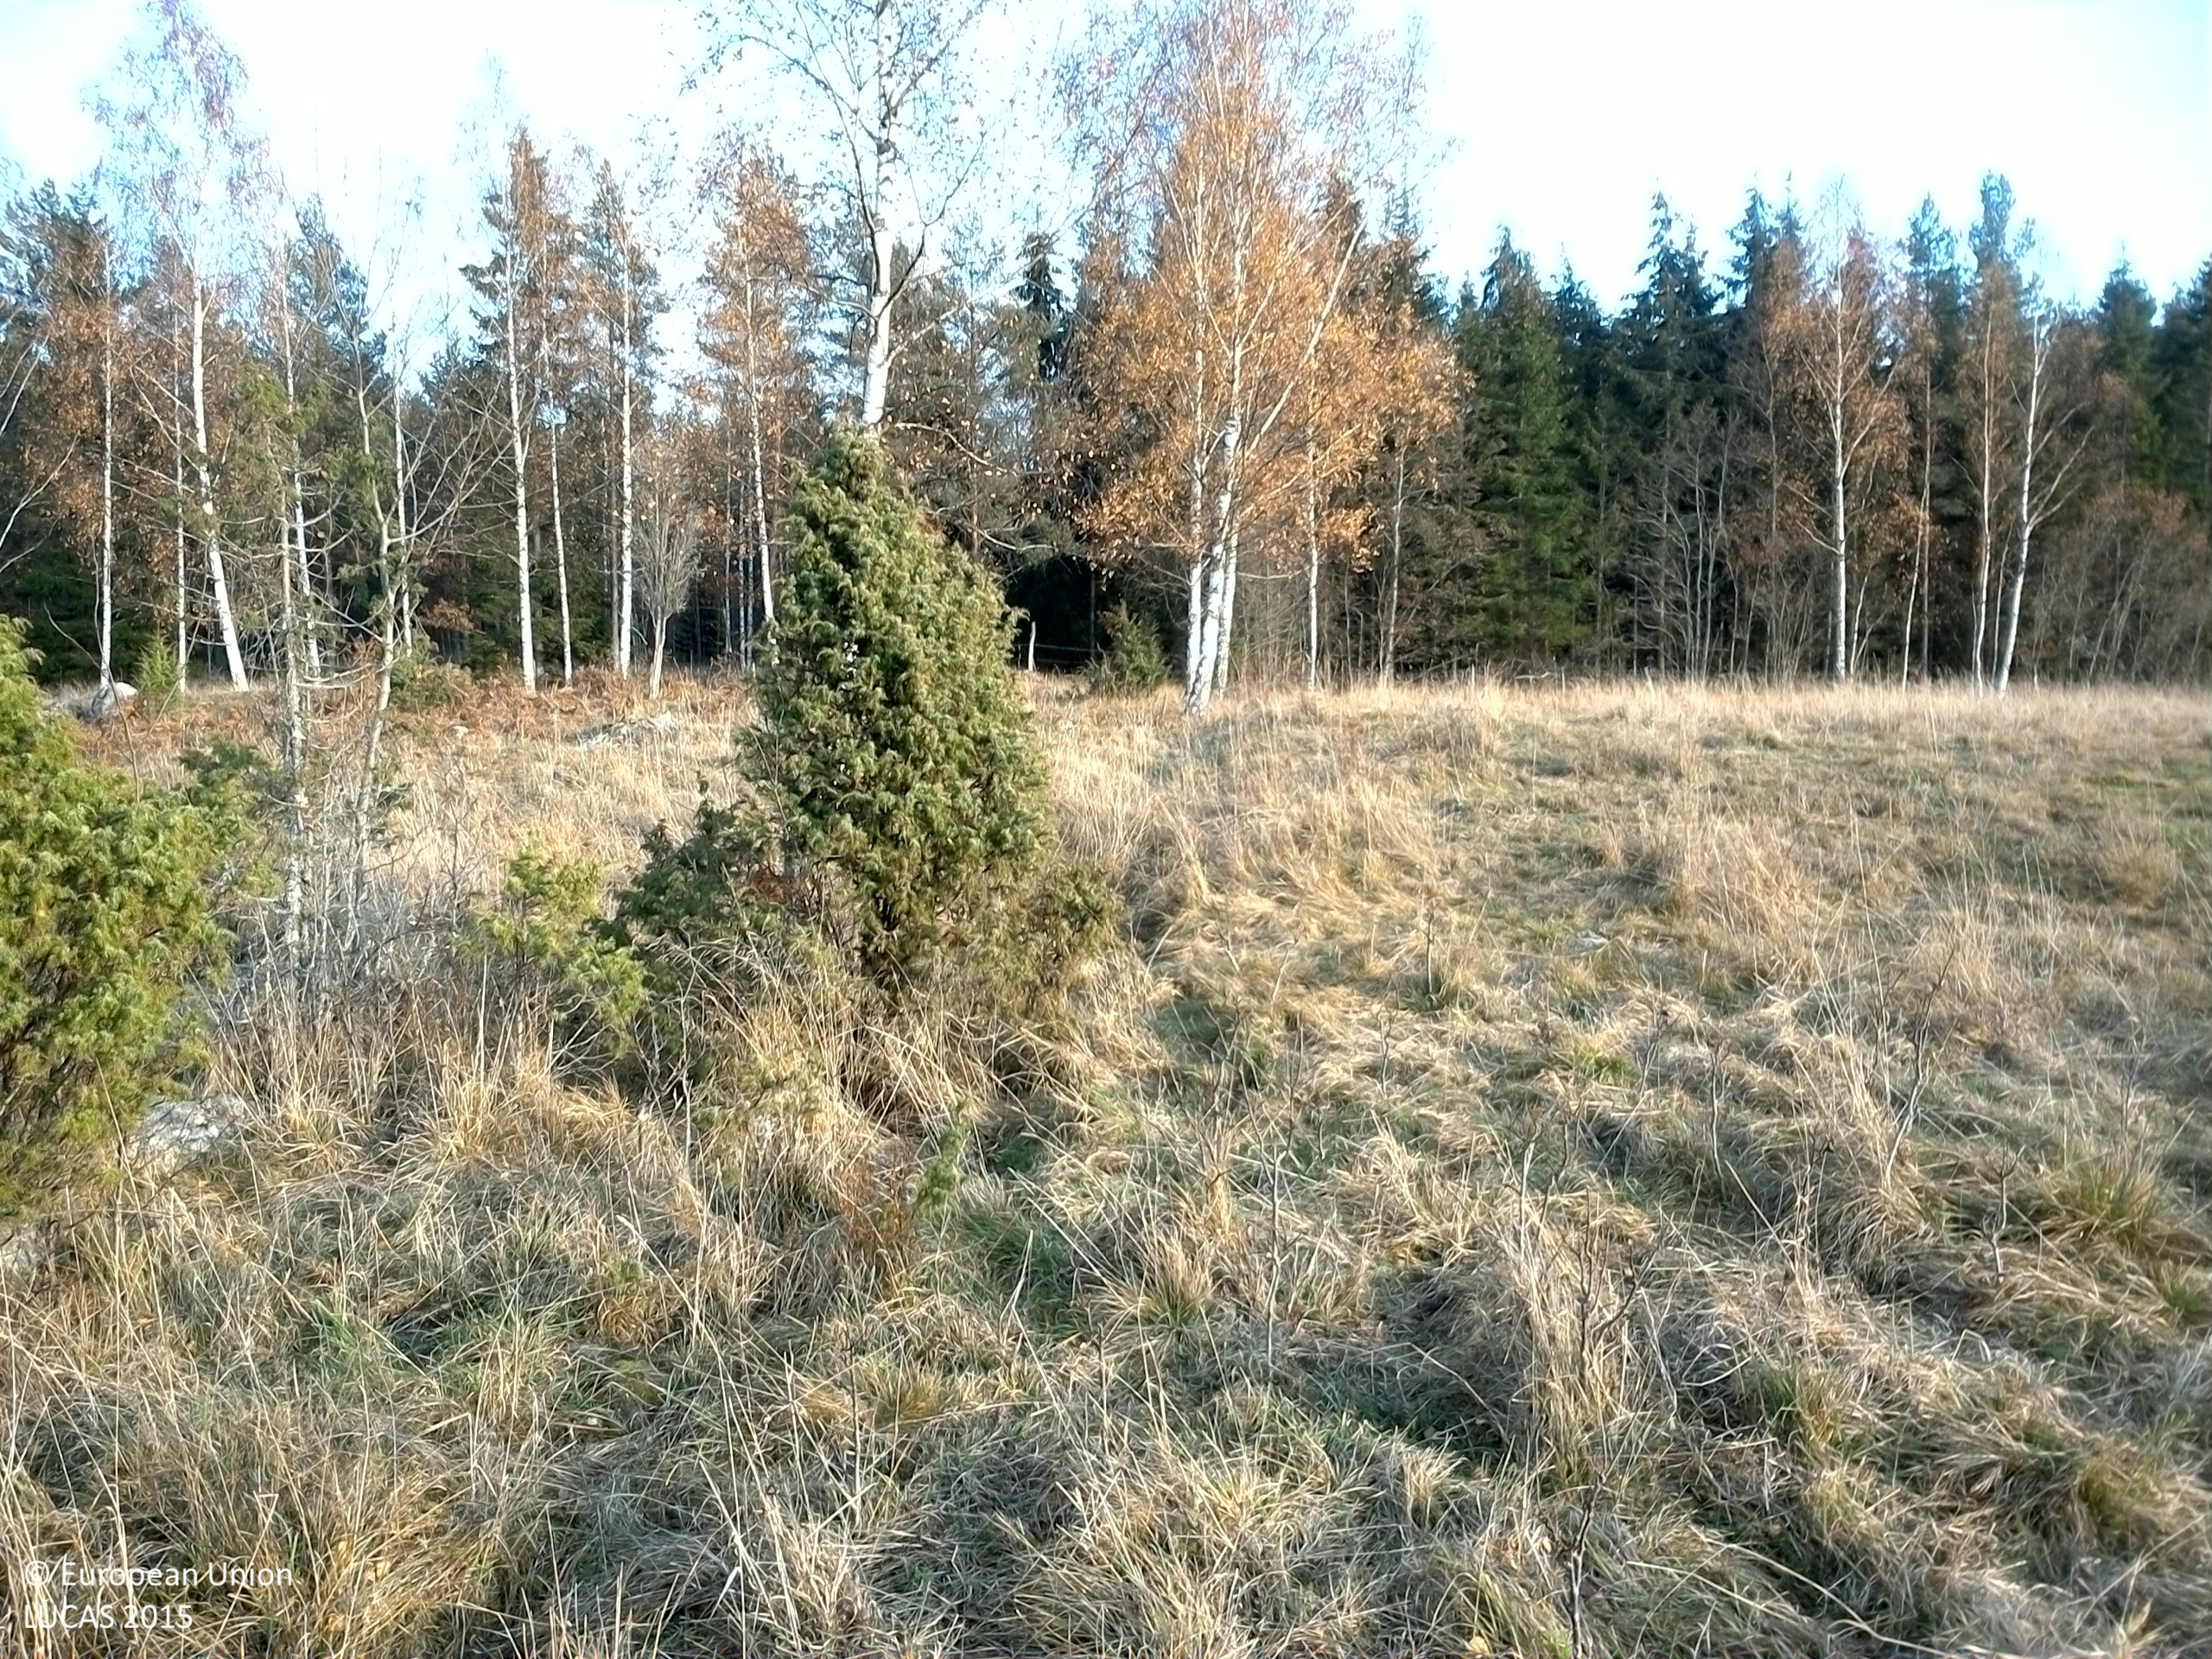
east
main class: Grassland
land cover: Grassland with sparse tree/shrub cover
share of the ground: > 75 %
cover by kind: herbaceous plants 90 %, broadleaved forest trees 5 %, shrubs 5 %
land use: Agriculture (excluding fallow land and kitchen gardens)
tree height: > 5 m
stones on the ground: < 10 %
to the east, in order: Grassland with sparse tree/shrub cover; Broadleaved woodland; Fences; Other mixed woodland; Pine dominated coniferous woodland; Spruce dominated coniferous woodland; Broadleaved woodland; Grassland with sparse tree/shrub cover
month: October
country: SE
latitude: 59.2409
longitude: 17.1300
